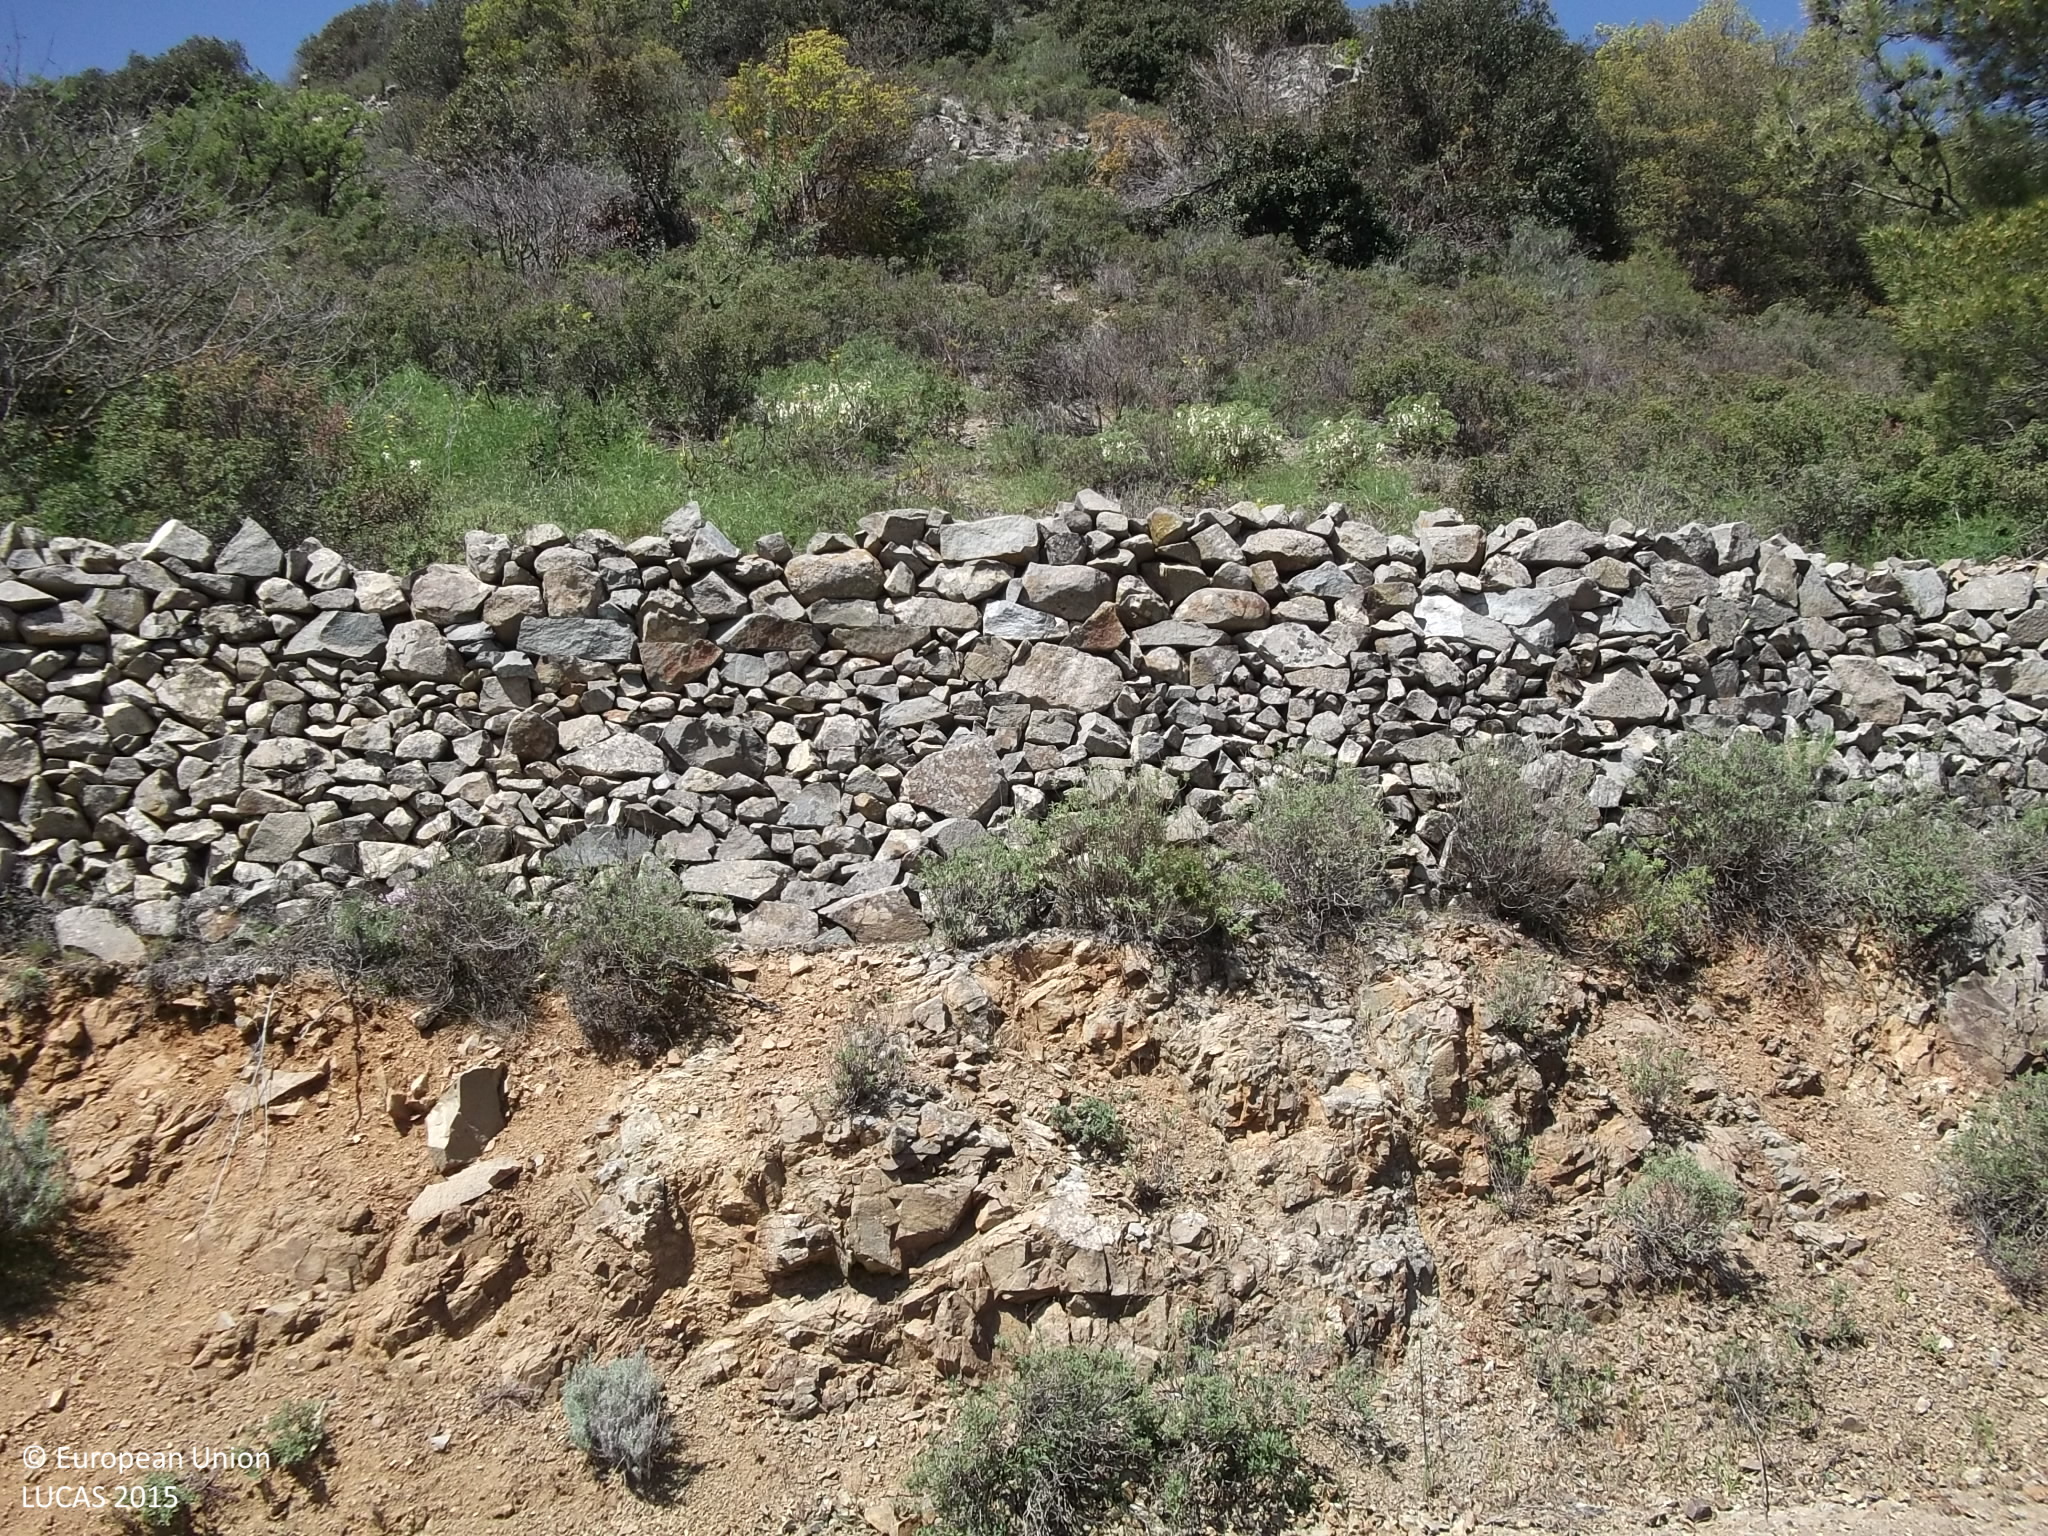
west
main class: Woodland
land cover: Broadleaved woodland
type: broadleaved evergreen forest
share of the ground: 25 - 50 %
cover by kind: broadleaved forest trees 45 %, shrubs 25 %, herbaceous plants 10 %, consolidated bare surface 10 %, unconsolidated bare surface 10 %
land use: Semi-natural and natural areas not in use
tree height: > 5 m
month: April
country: CY
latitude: 34.8994
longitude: 33.1008
